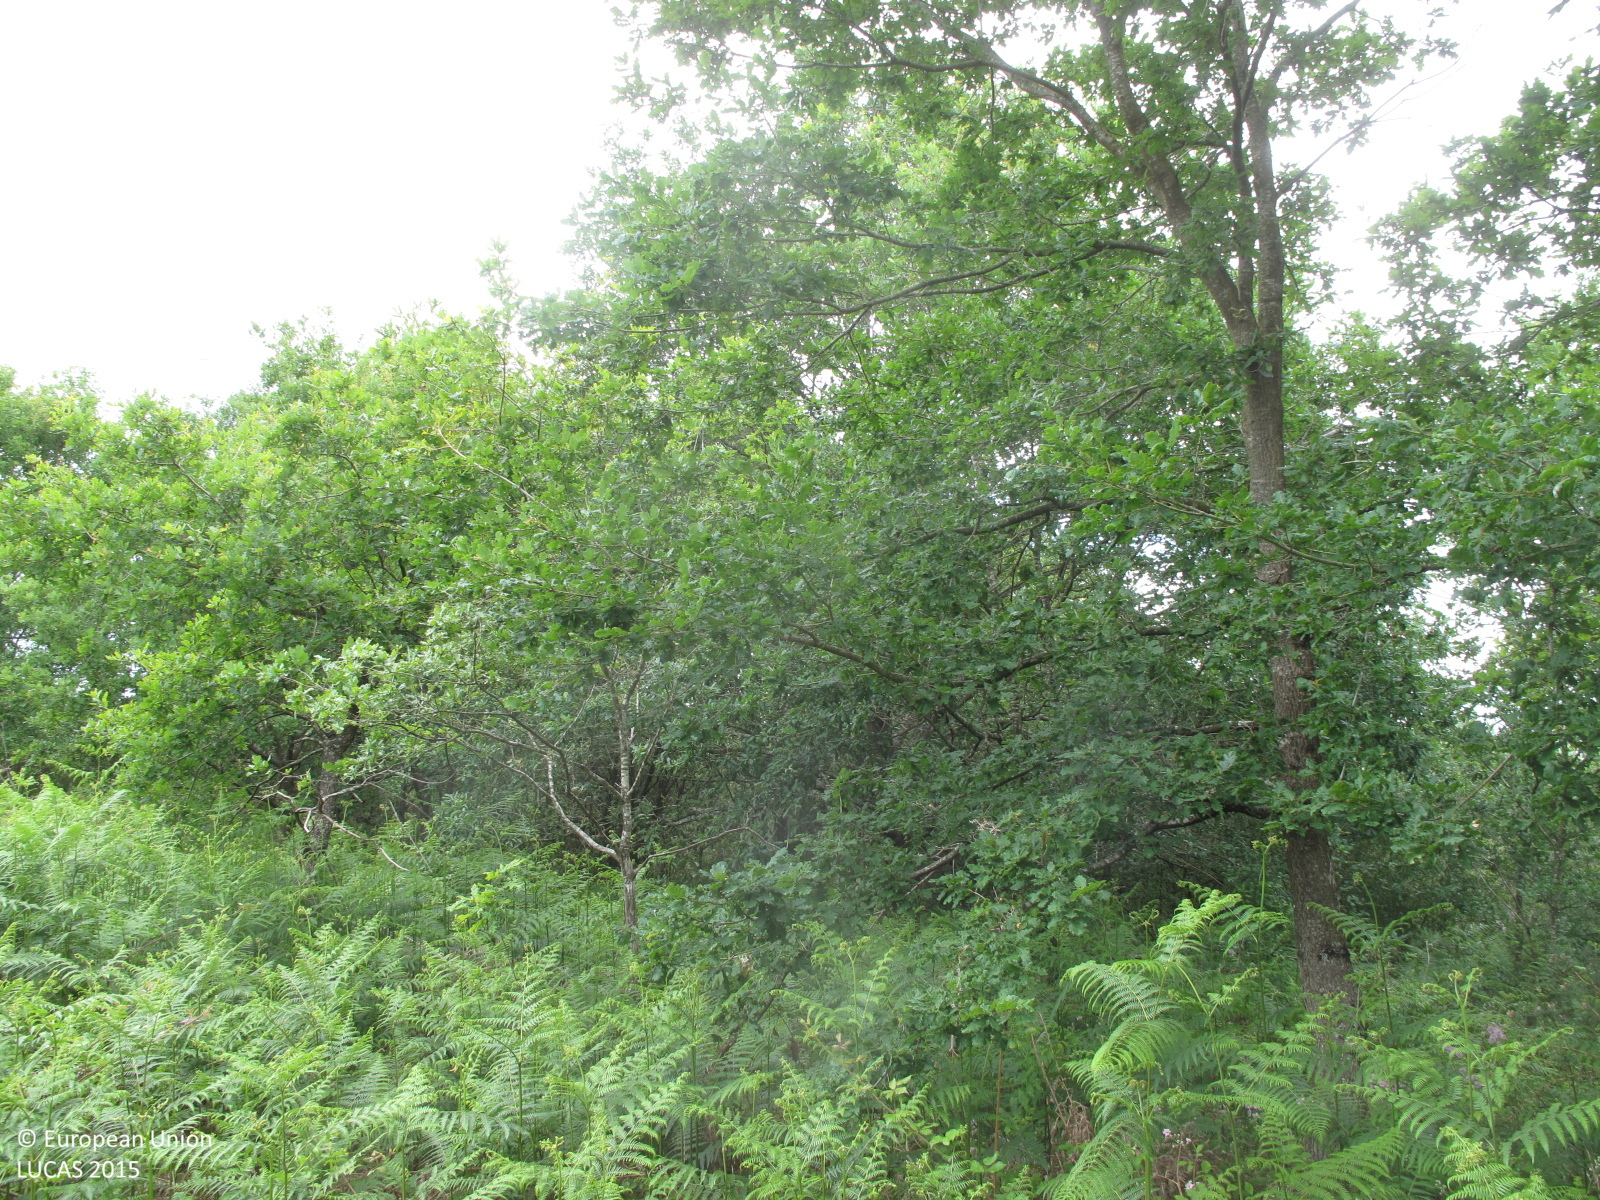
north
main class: Woodland
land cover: Broadleaved woodland
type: acidophilous oak and oak-birch forest
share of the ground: 50 - 75 %
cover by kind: broadleaved forest trees 60 %, shrubs 30 %, herbaceous plants 10 %
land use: Semi-natural and natural areas not in use
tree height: > 5 m
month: June
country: ES
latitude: 43.0943
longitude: -8.4977
